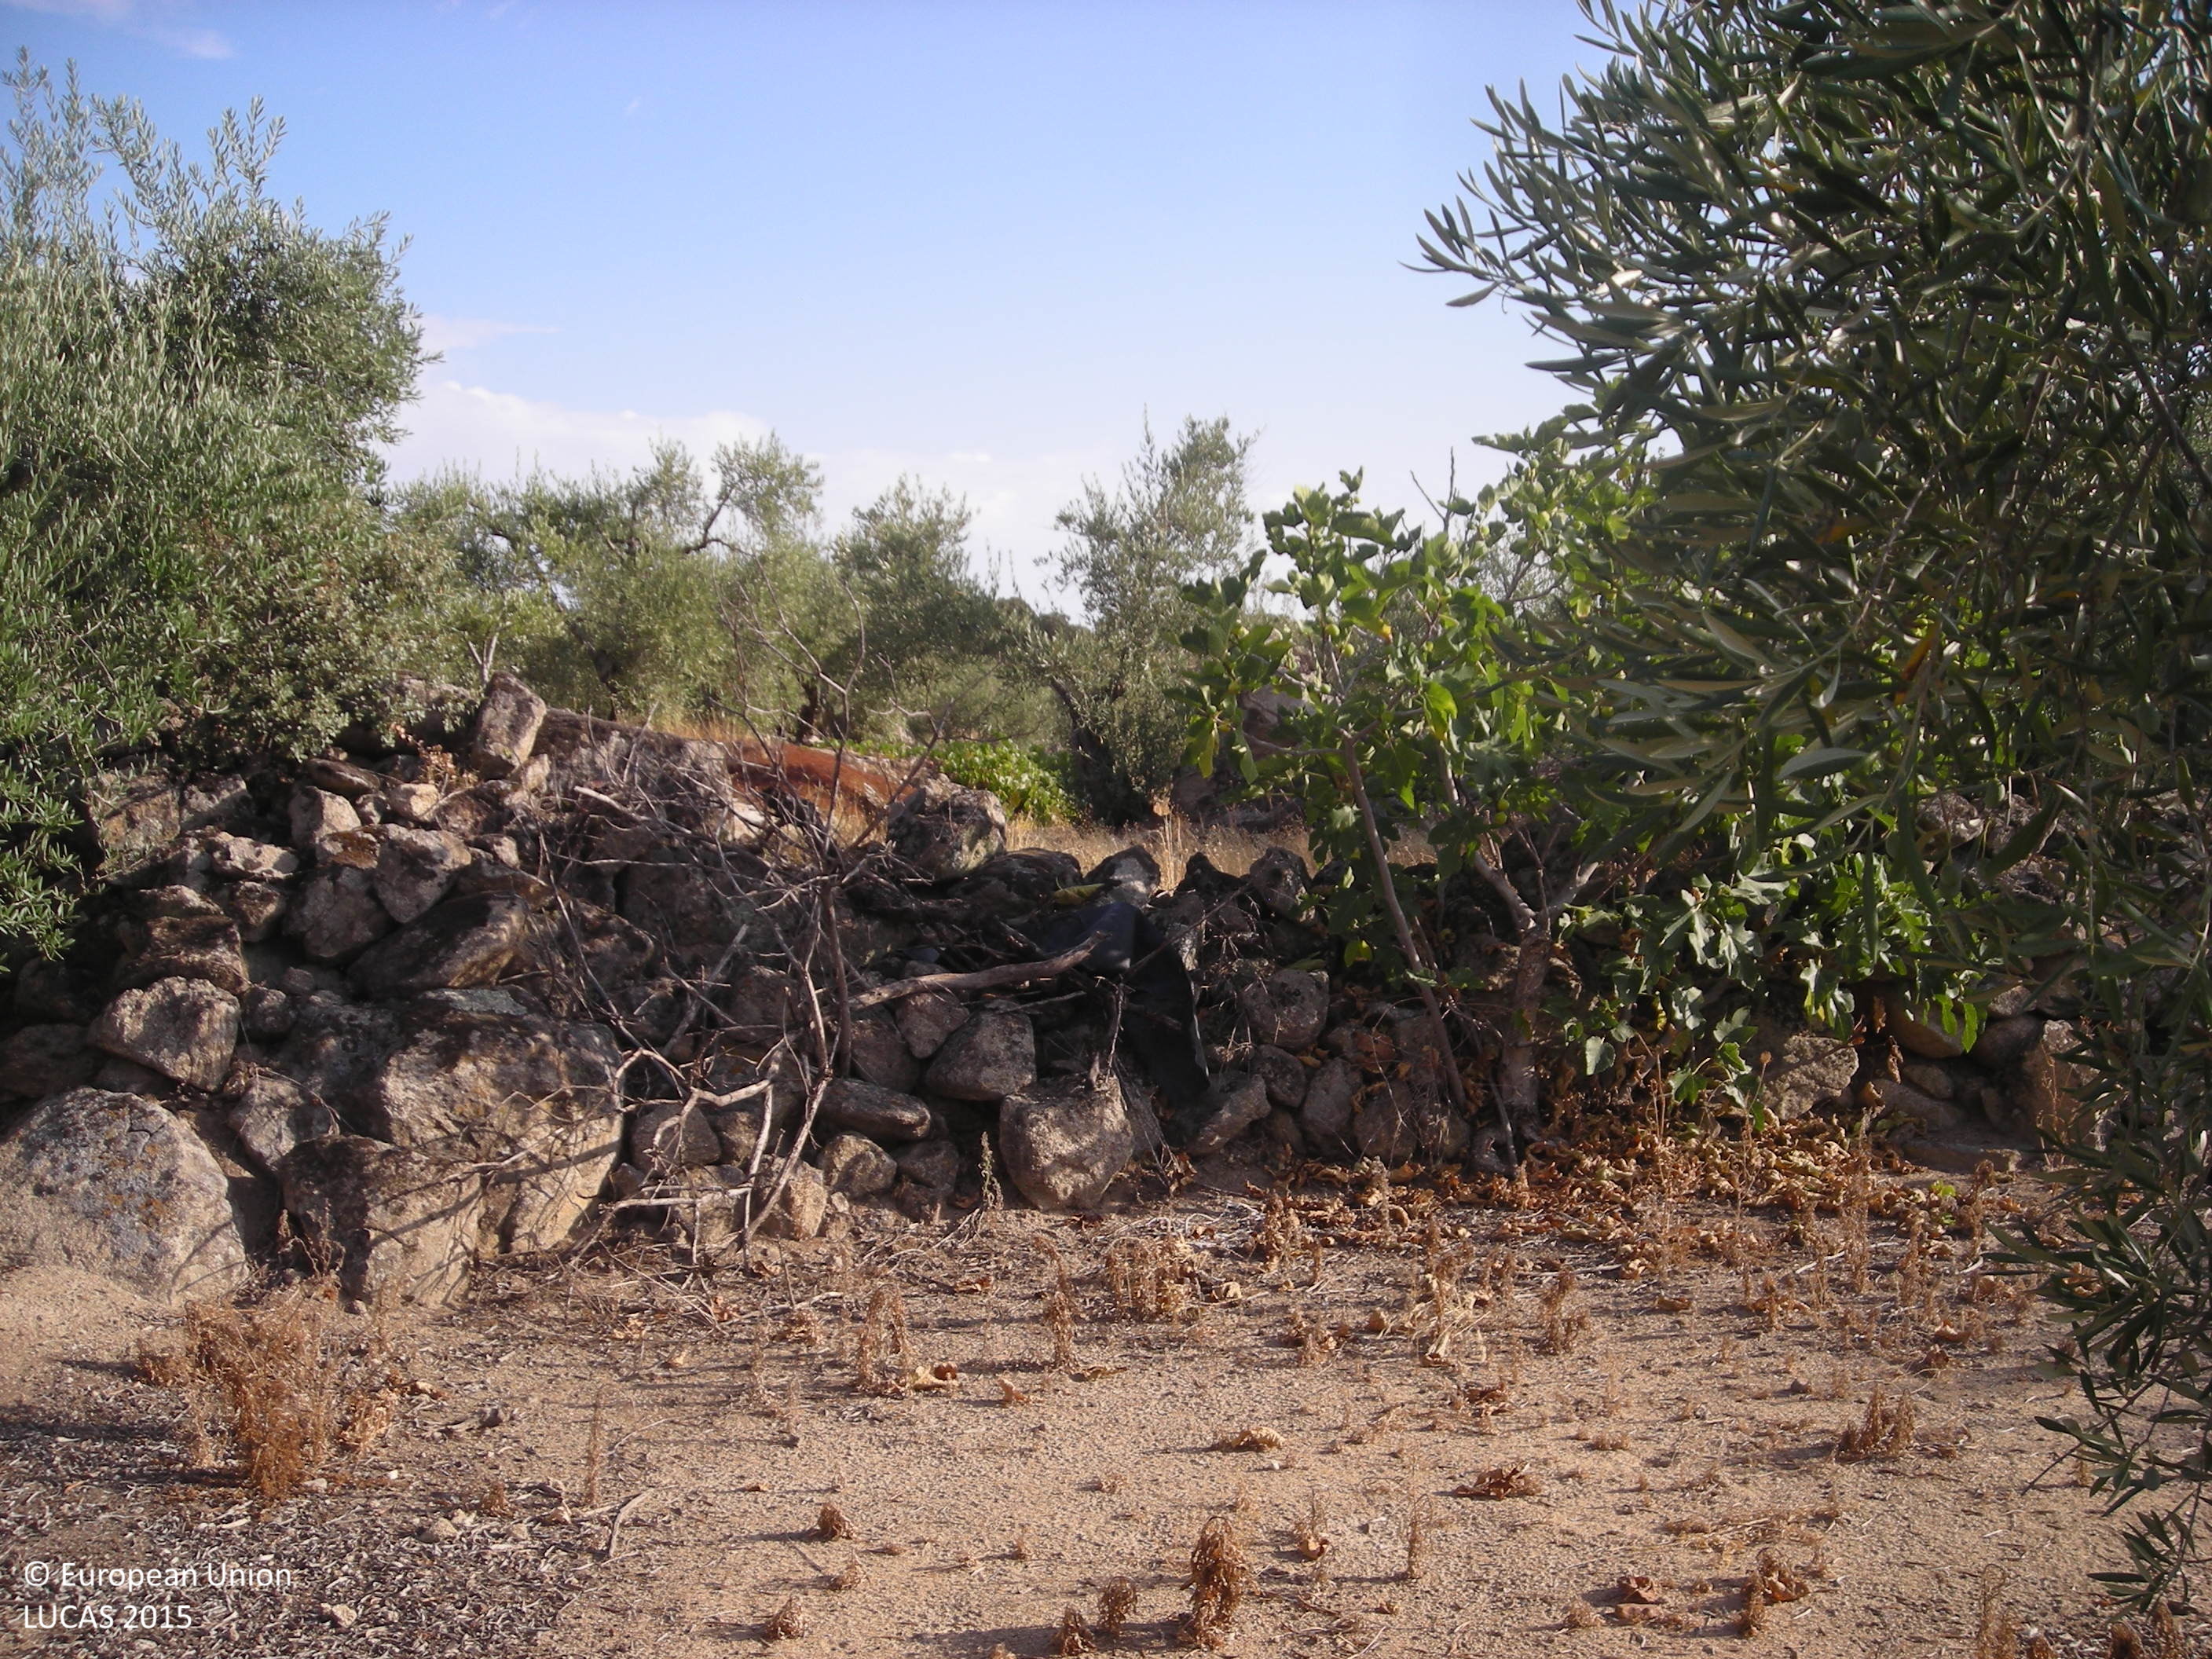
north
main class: Cropland
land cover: Olive groves
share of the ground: 50 - 75 %
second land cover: Other bare soil
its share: > 75 %
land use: Agriculture (excluding fallow land and kitchen gardens)
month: July
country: ES
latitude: 39.1566
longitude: -5.9429
